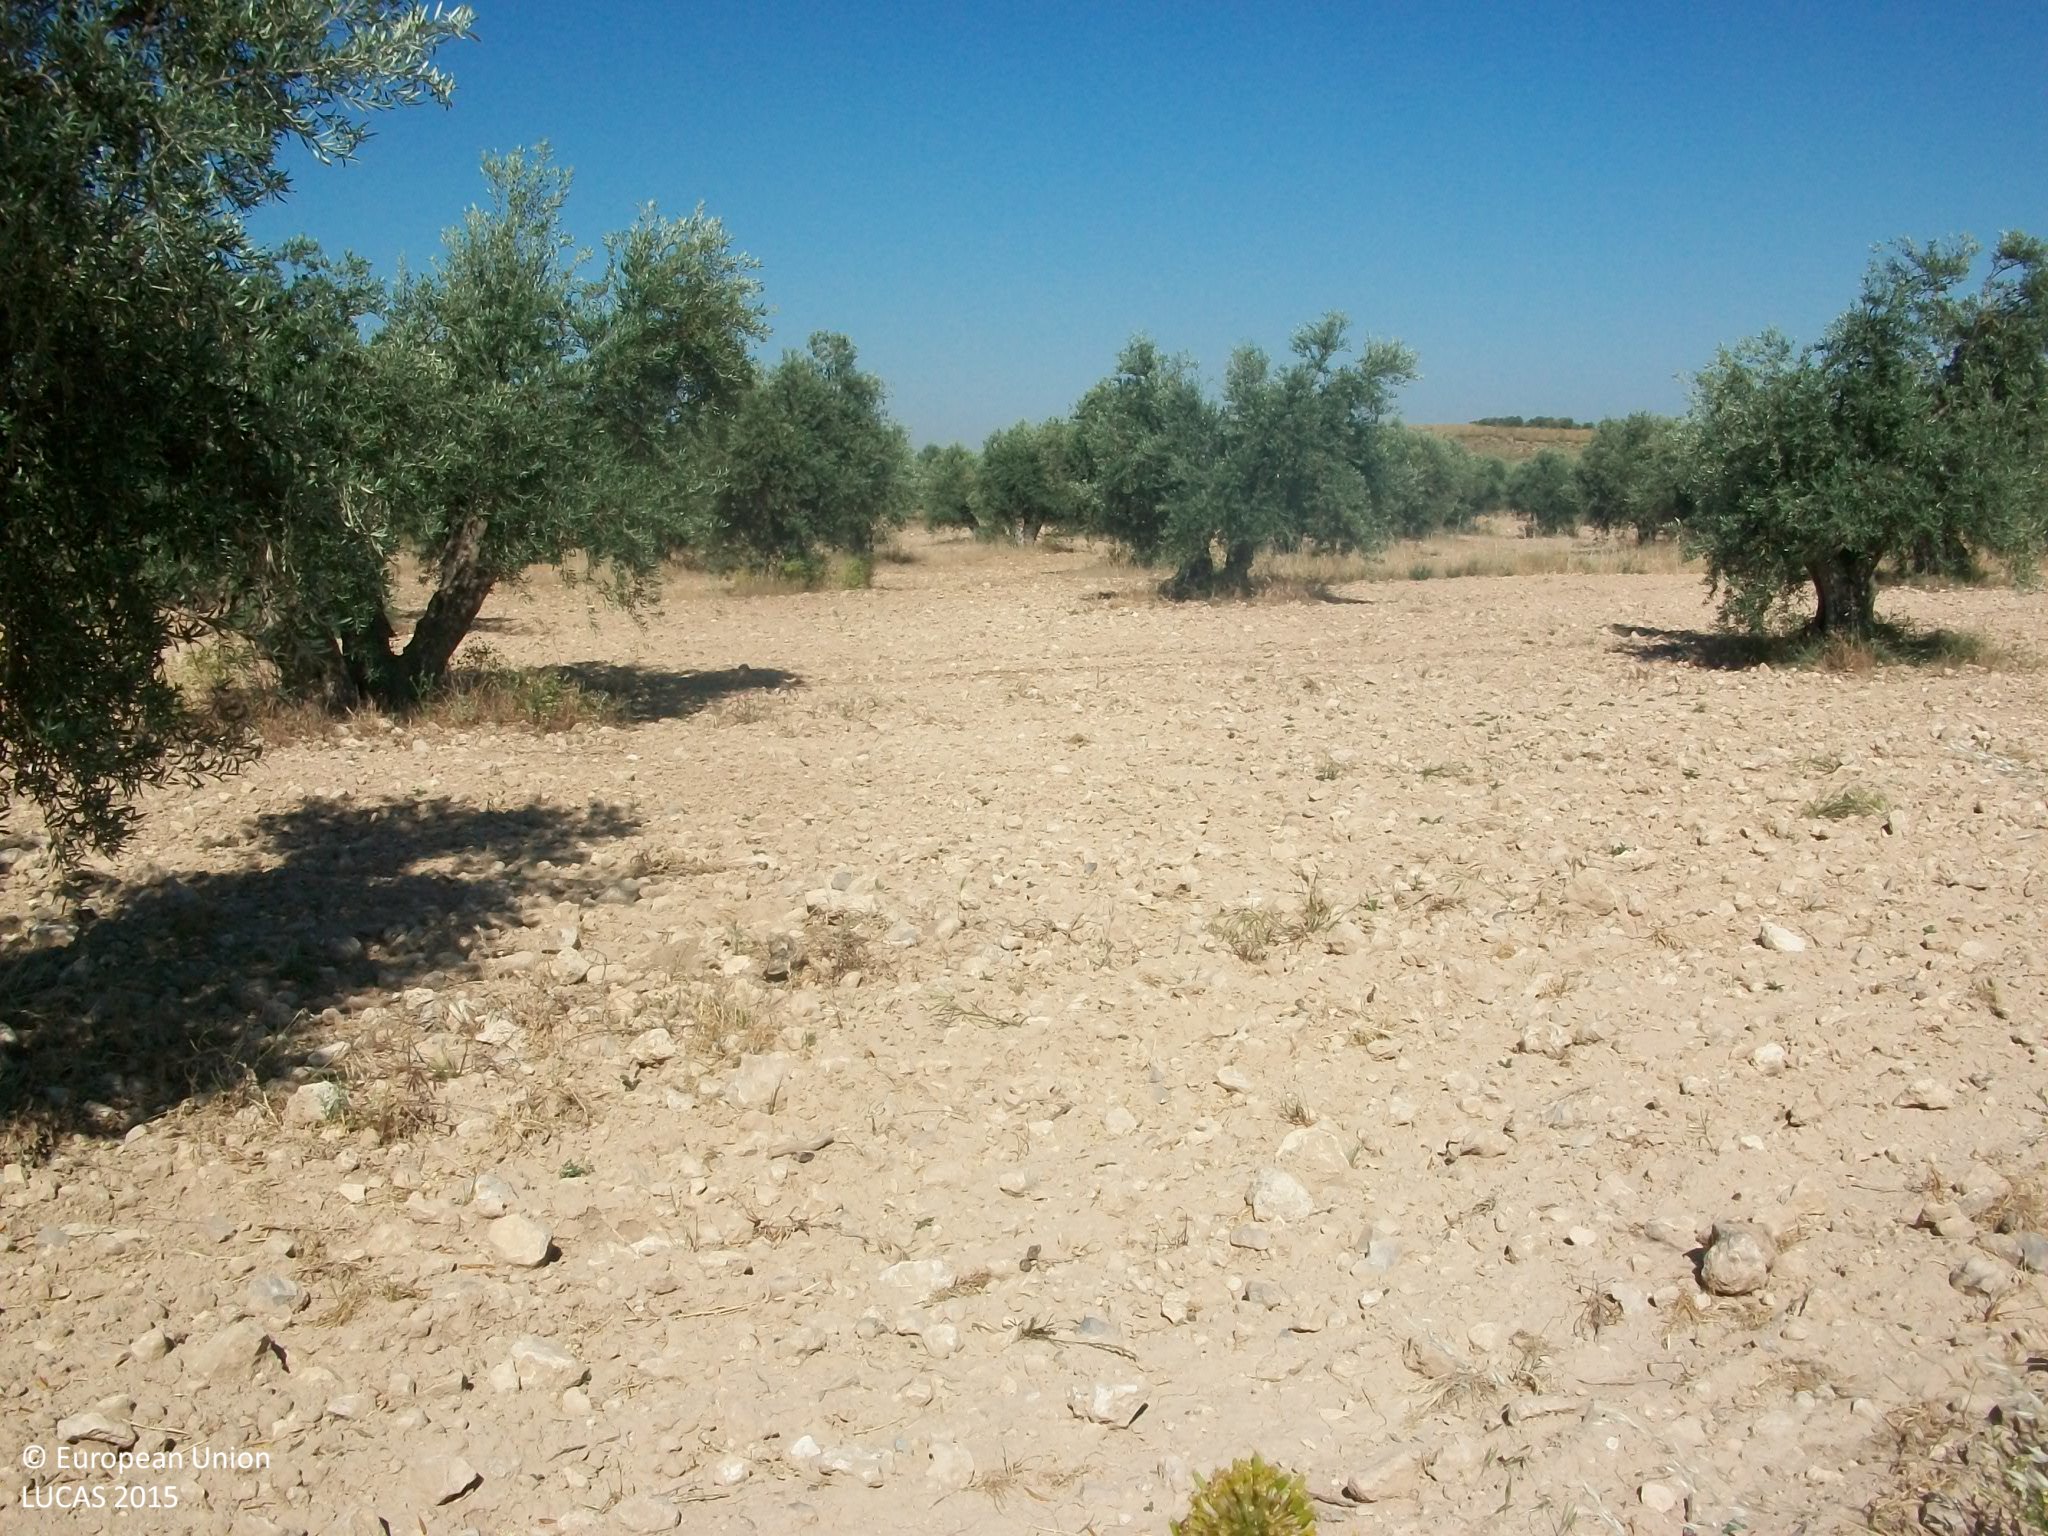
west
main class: Cropland
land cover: Olive groves
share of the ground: 25 - 50 %
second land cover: Other bare soil
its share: > 75 %
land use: Agriculture (excluding fallow land and kitchen gardens)
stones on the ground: > 50 %
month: May
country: ES
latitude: 39.9505
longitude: -3.6433
